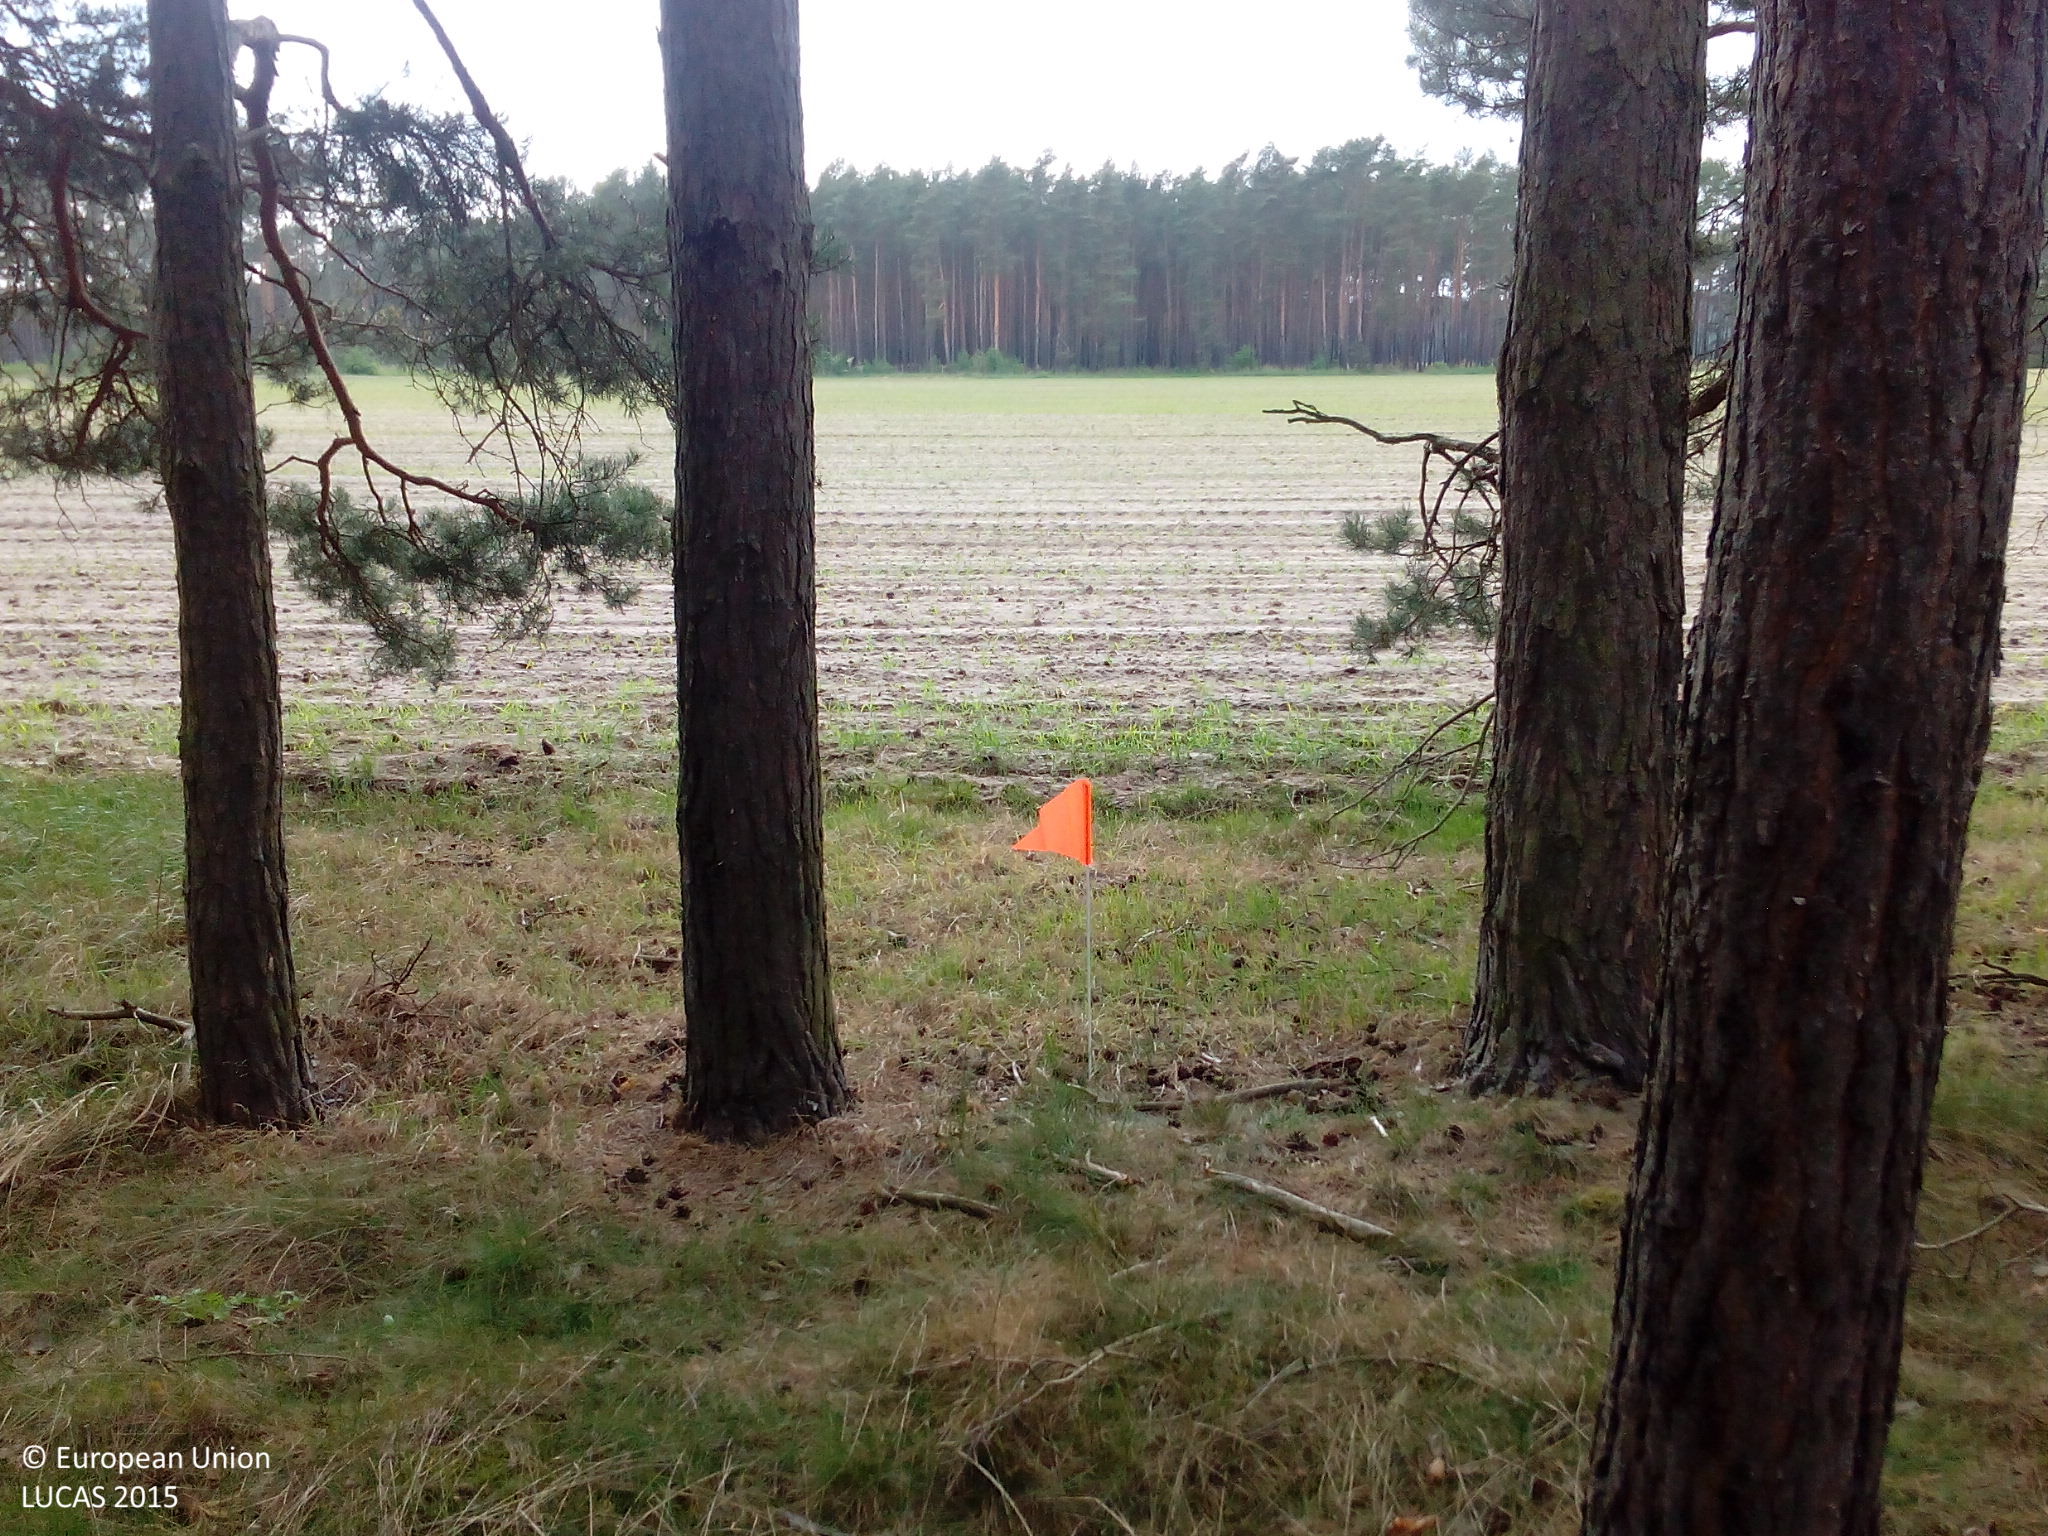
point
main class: Woodland
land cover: Pine dominated coniferous woodland
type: hemiboreal forest and nemoral coniferous forest and mixed broadleaved-coniferous forest
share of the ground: > 75 %
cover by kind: coniferous forest trees 80 %, herbaceous plants 15 %, unconsolidated bare surface 5 %
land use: Forestry
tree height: > 5 m
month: May
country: DE
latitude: 52.1732
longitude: 13.1731
